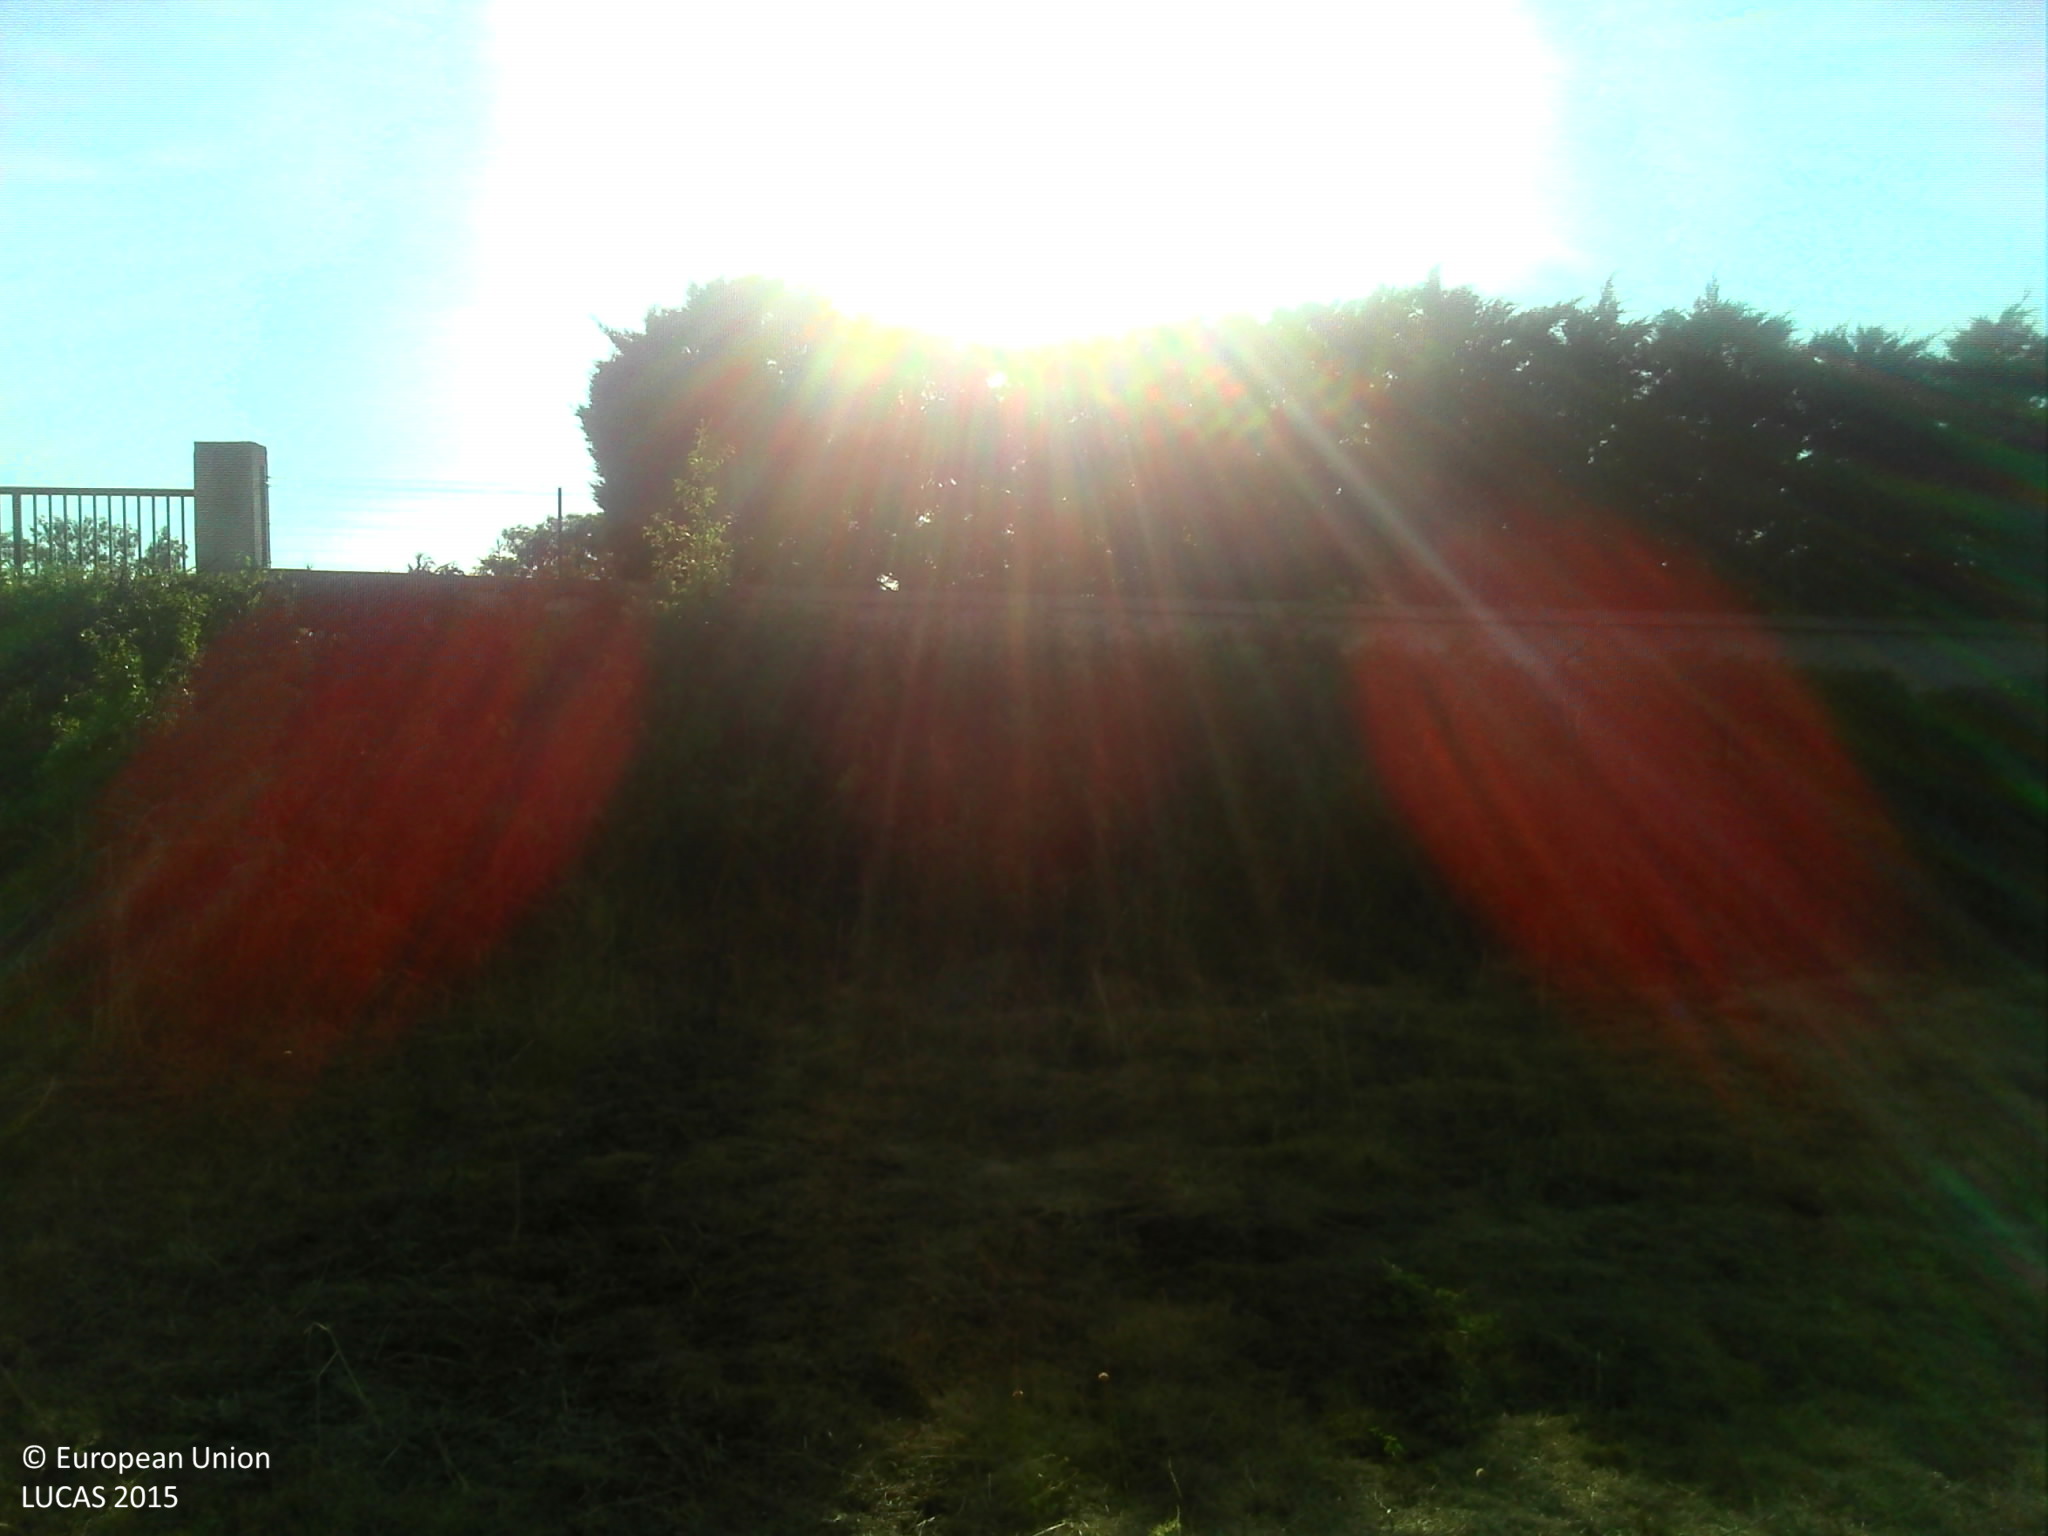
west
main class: Grassland
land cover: Grassland without tree/shrub cover
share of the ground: > 75 %
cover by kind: herbaceous plants 100 %
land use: Agriculture (excluding fallow land and kitchen gardens)
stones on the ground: < 10 %
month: July
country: FR
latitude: 44.9984
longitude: 3.8263
